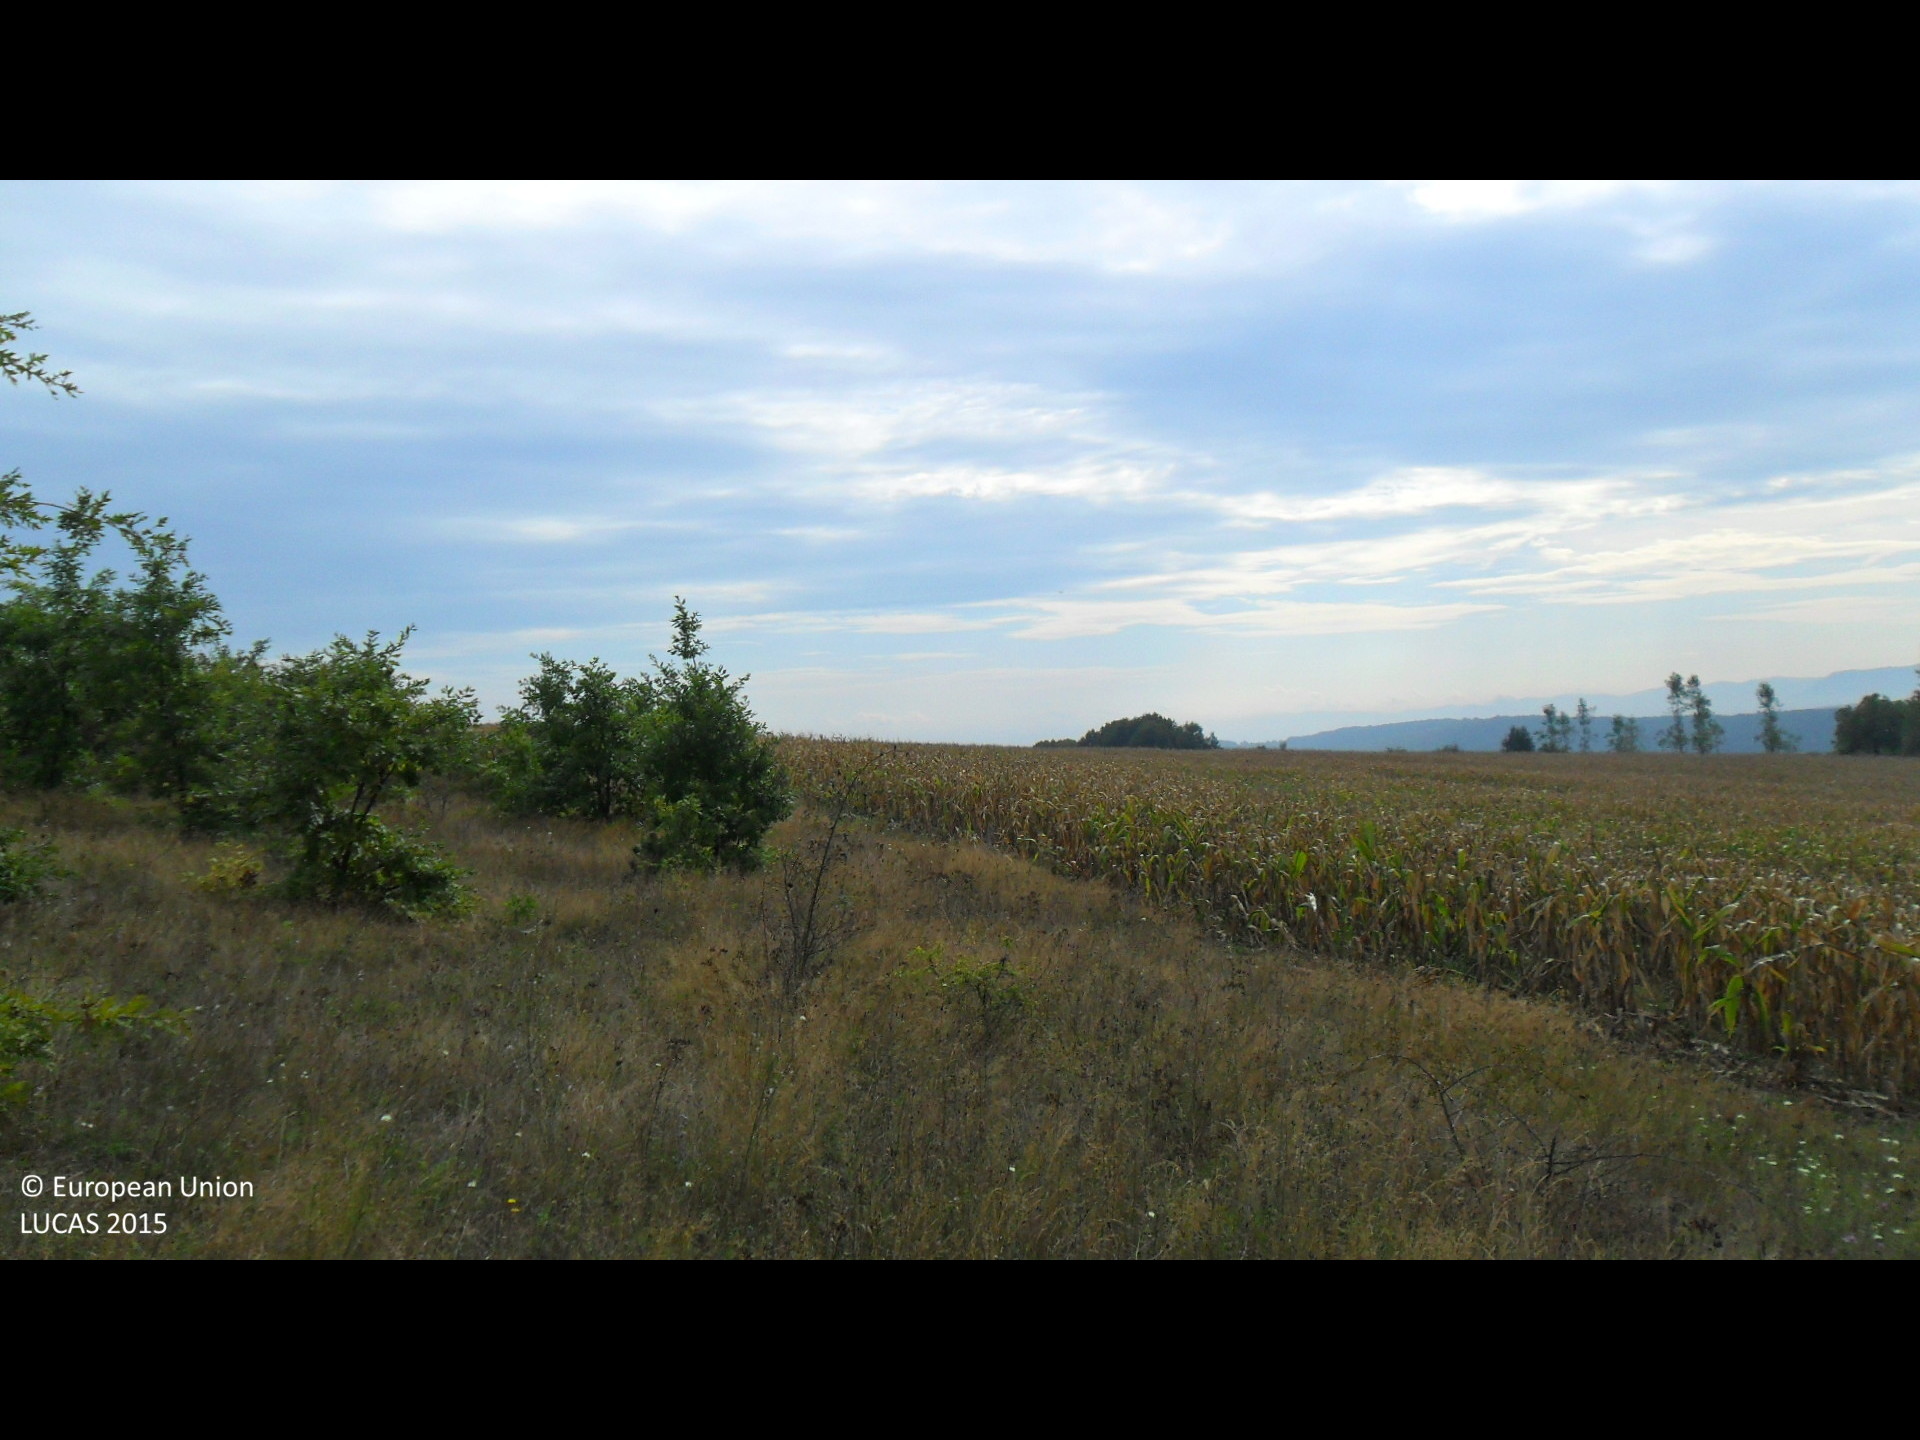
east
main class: Grassland
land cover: Grassland with sparse tree/shrub cover
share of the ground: > 75 %
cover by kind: herbaceous plants 90 %, broadleaved forest trees 5 %, shrubs 5 %
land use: Agriculture (excluding fallow land and kitchen gardens)
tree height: < 5 m
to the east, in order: Grassland with sparse tree/shrub cover; Maize
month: September
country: BG
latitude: 43.0863
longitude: 26.4232
